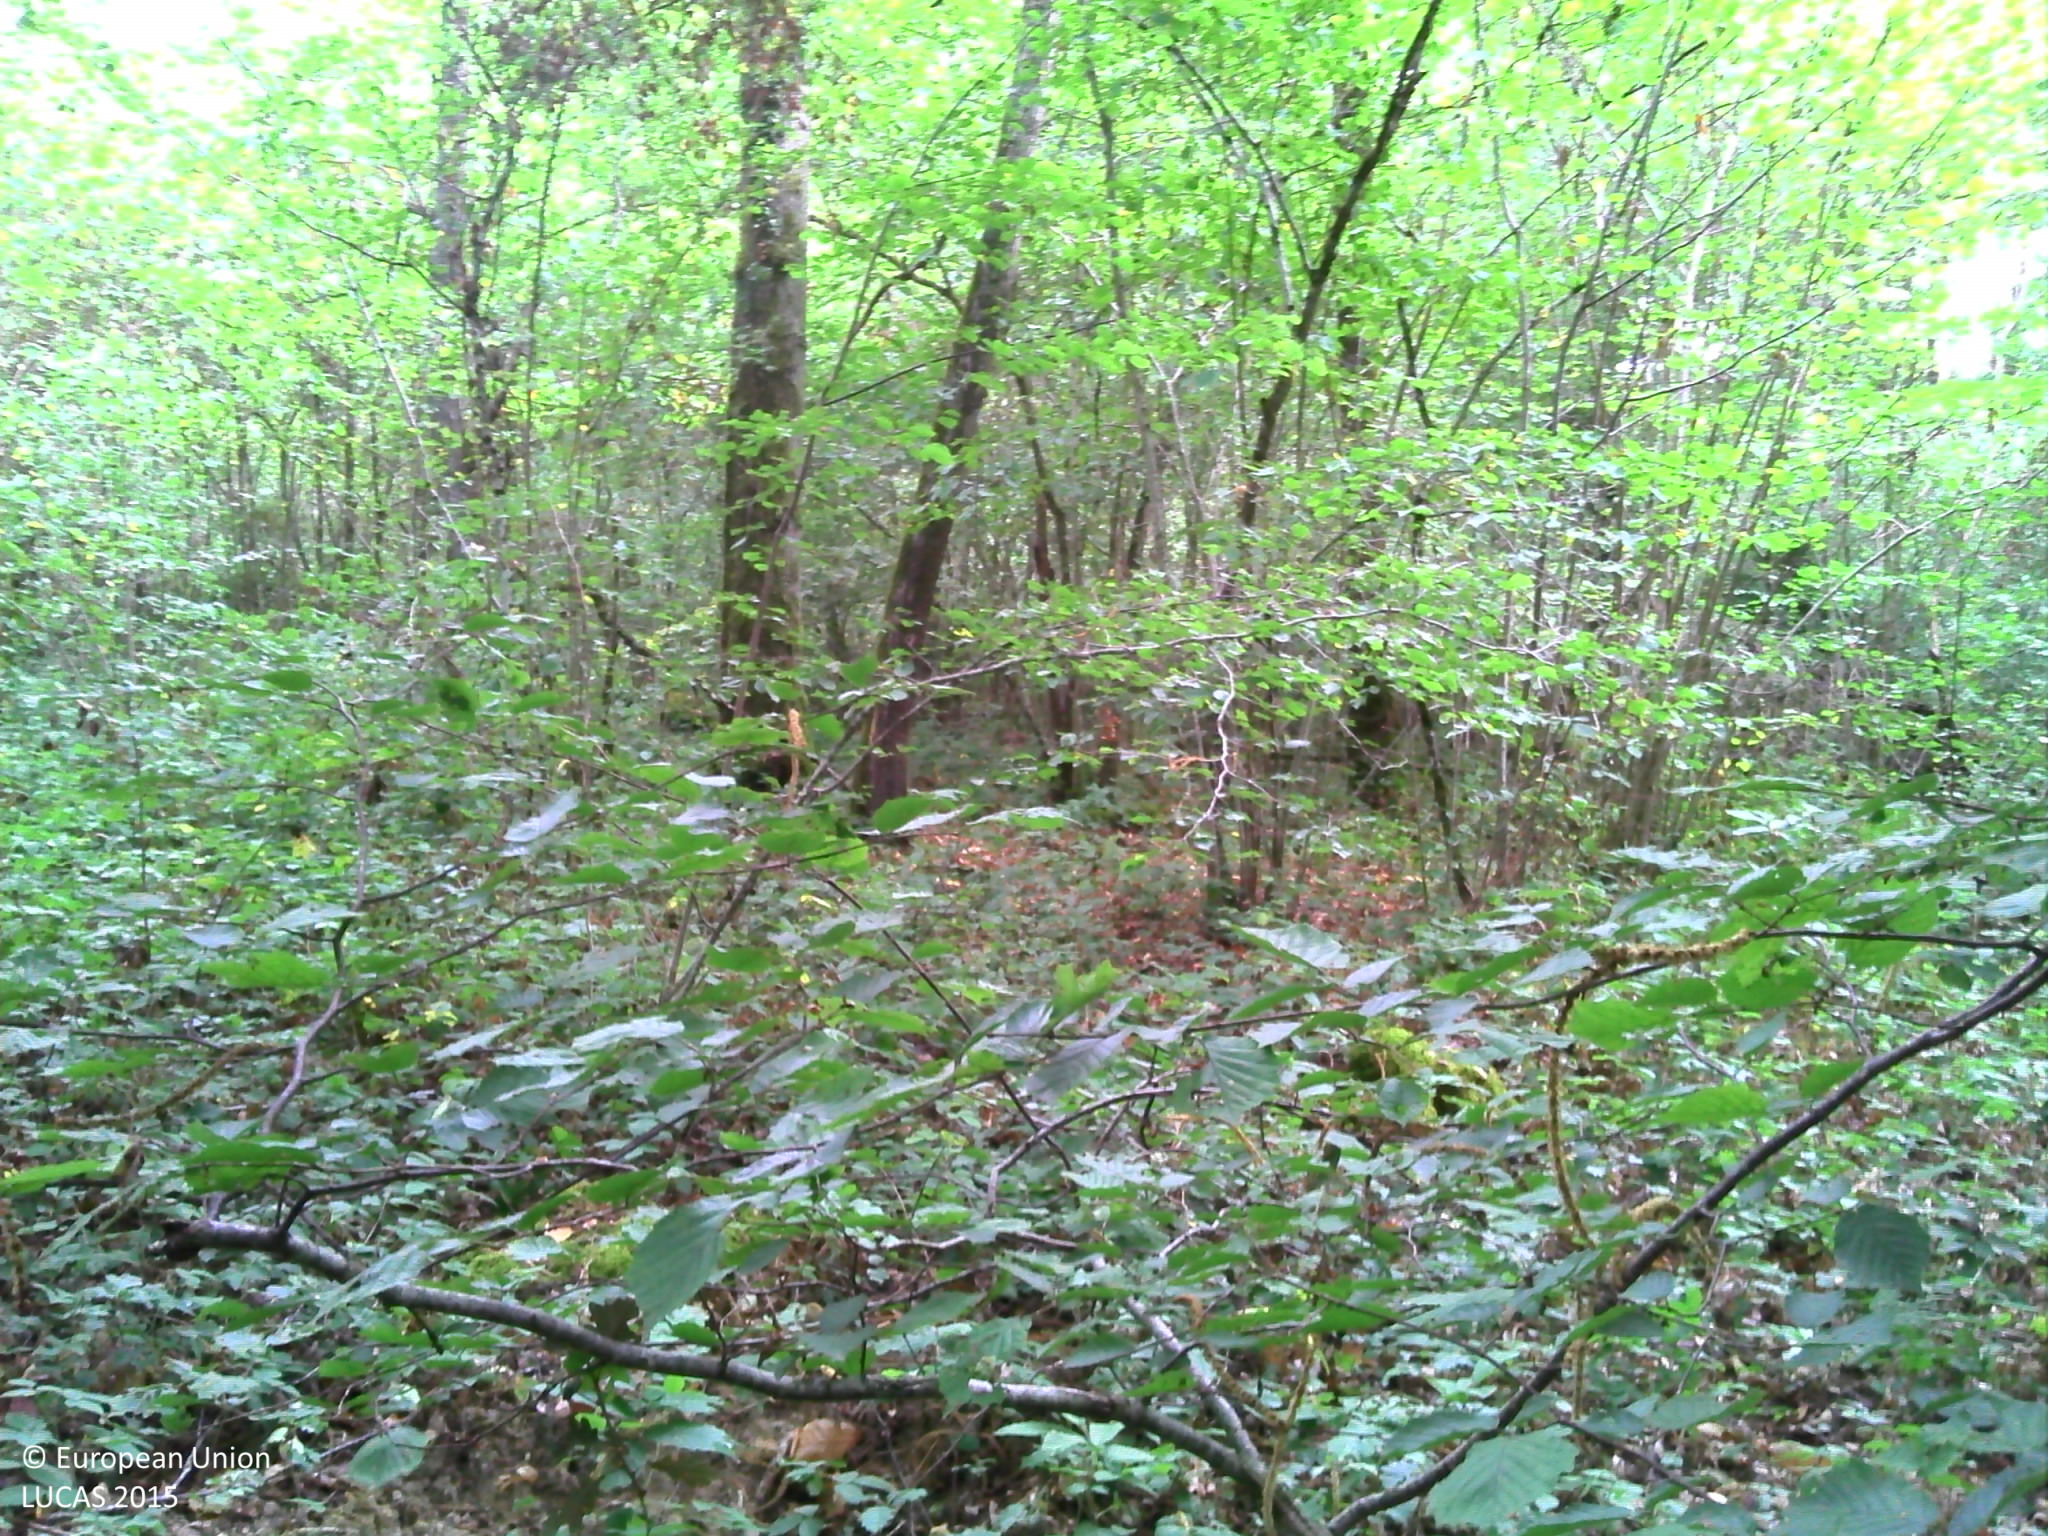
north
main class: Woodland
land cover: Broadleaved woodland
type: mesophytic deciduous forest
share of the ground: > 75 %
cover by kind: broadleaved forest trees 90 %, herbaceous plants 5 %, lichens and mosses 5 %
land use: Forestry
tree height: > 5 m
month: July
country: FR
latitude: 48.1354
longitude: 3.4233
